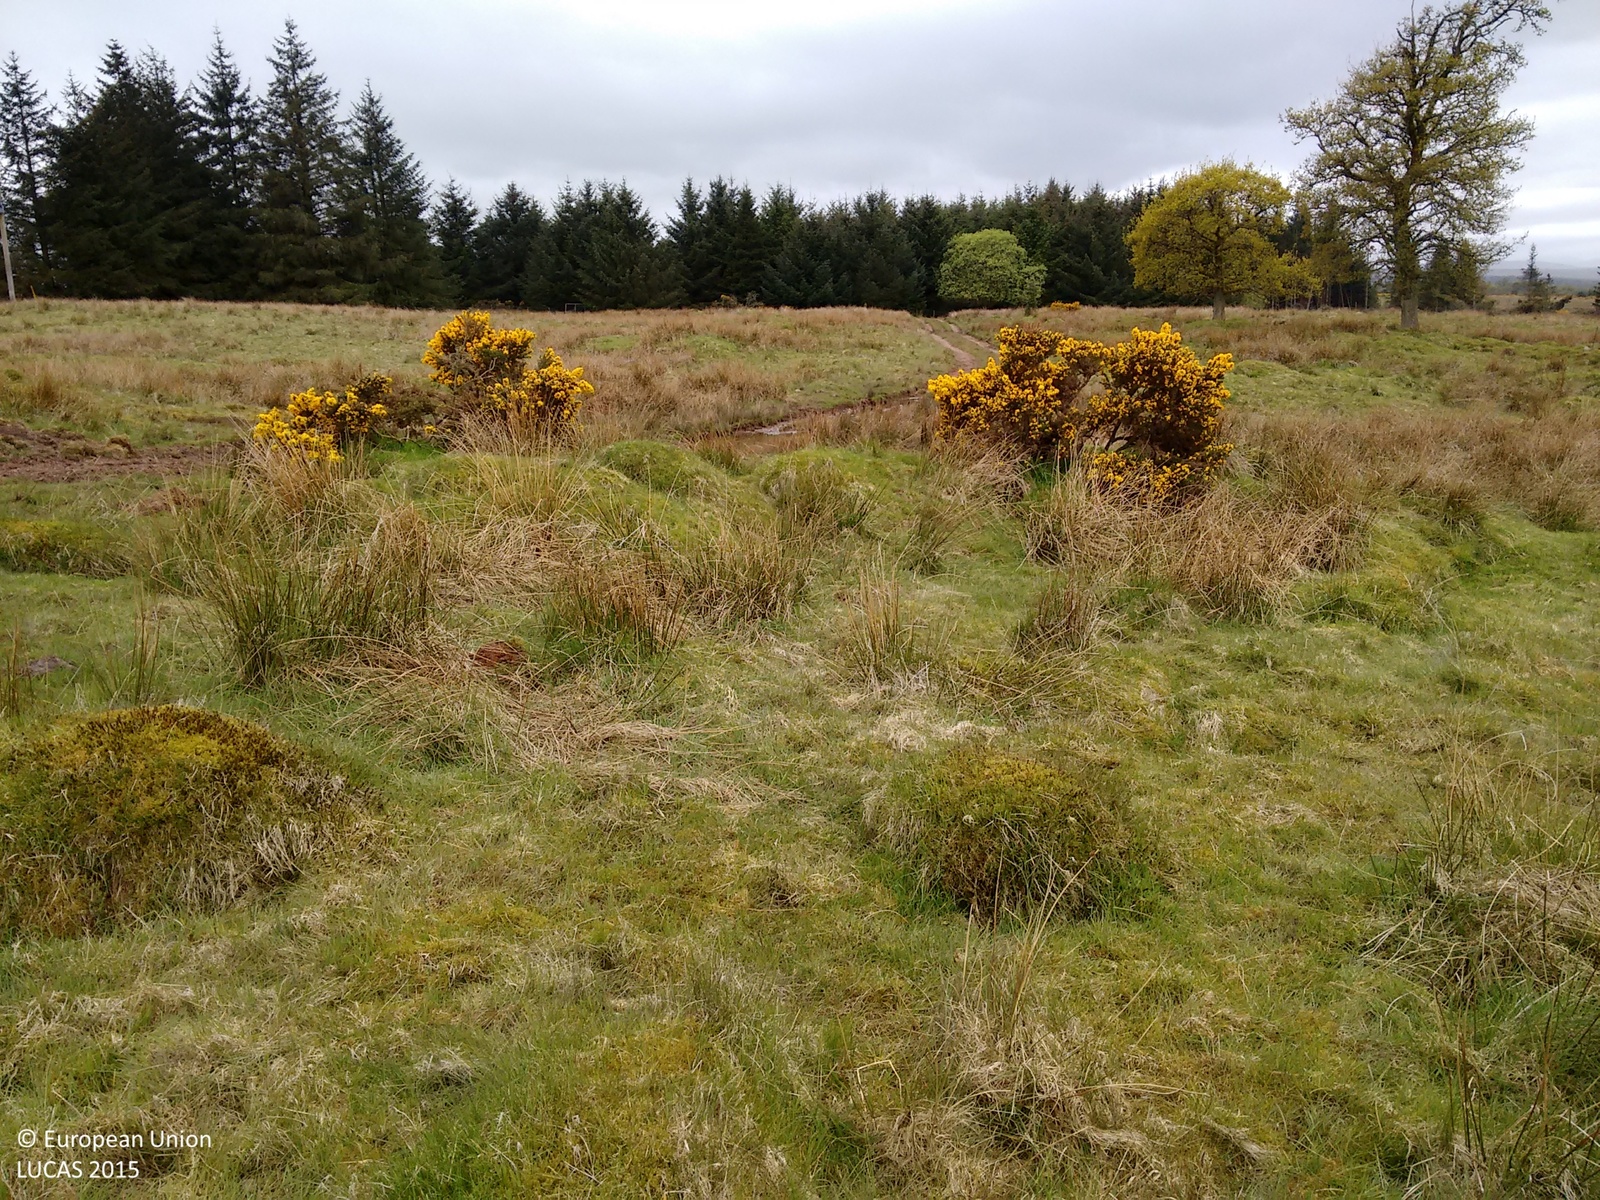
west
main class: Grassland
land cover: Grassland with sparse tree/shrub cover
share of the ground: > 75 %
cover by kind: herbaceous plants 85 %, broadleaved forest trees 5 %, shrubs 5 %, consolidated bare surface 5 %
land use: Agriculture (excluding fallow land and kitchen gardens)
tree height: > 5 m
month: May
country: GB
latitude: 56.2960
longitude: -3.8006
